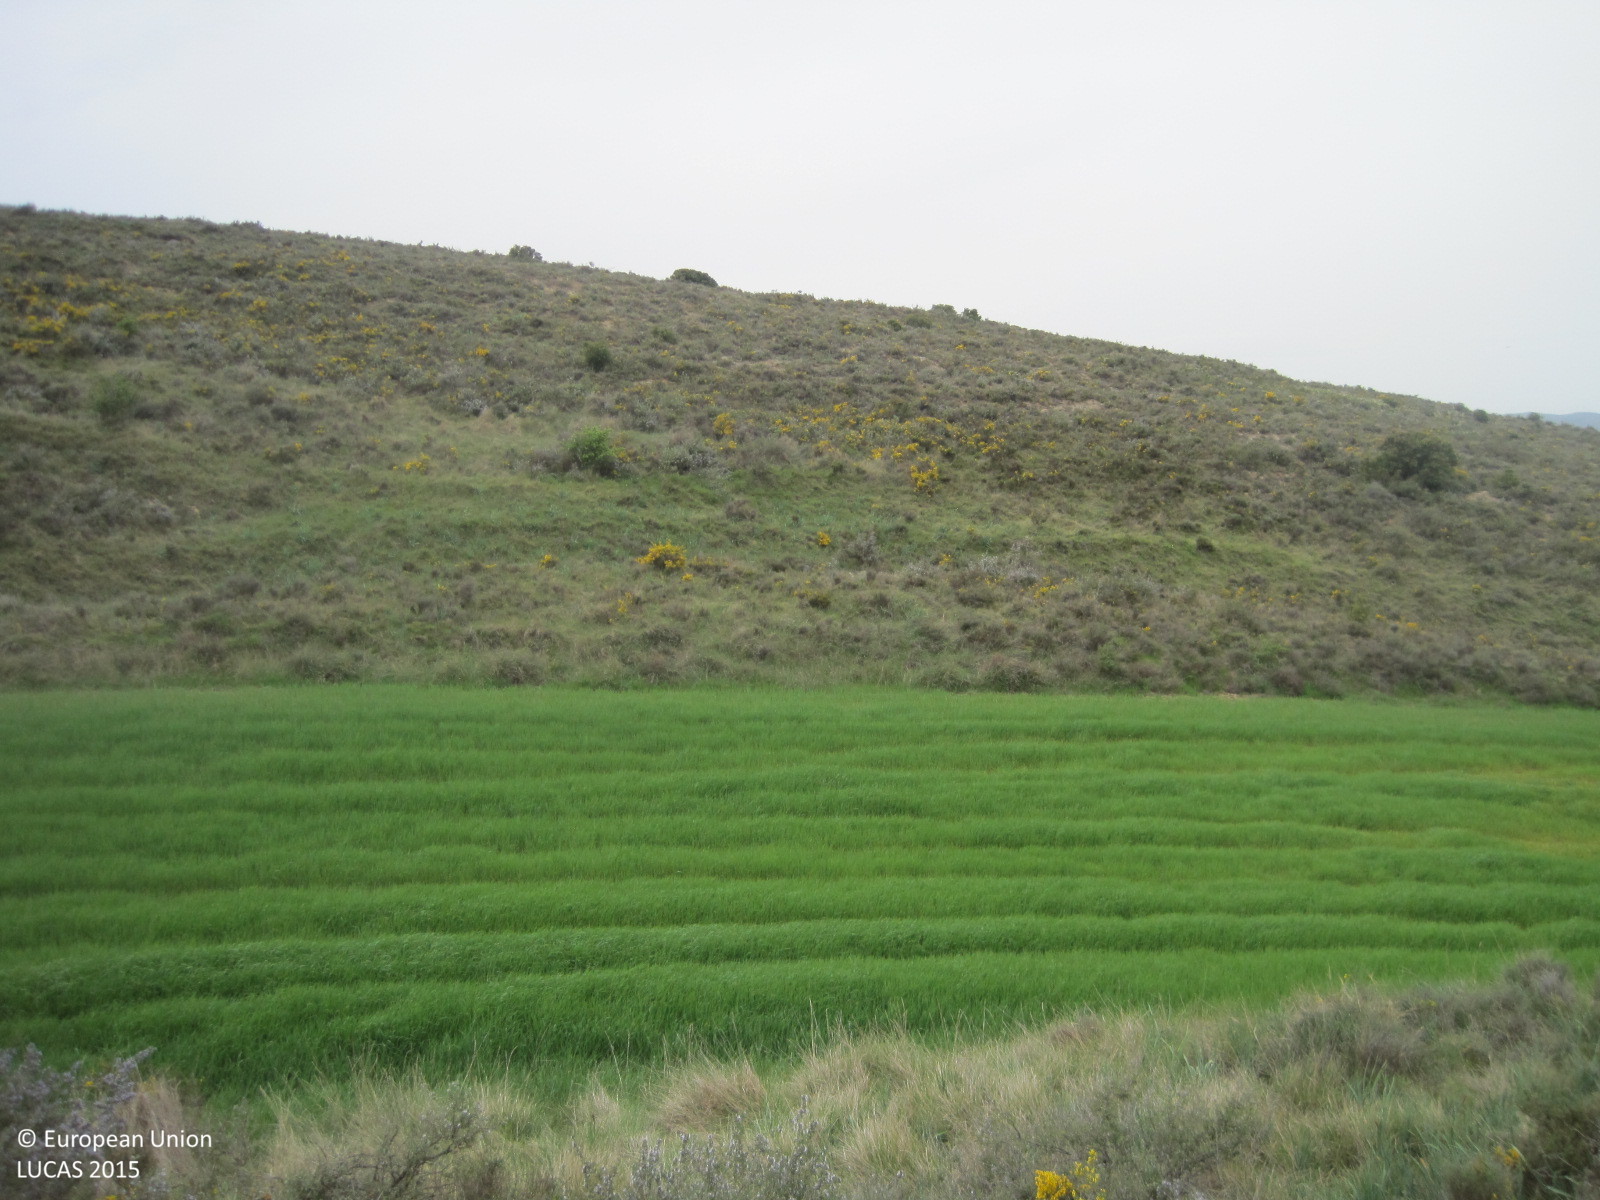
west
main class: Shrubland
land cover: Shrubland without tree cover
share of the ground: > 75 %
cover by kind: shrubs 60 %, unconsolidated bare surface 40 %
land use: Semi-natural and natural areas not in use
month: April
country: ES
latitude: 42.5183
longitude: -2.1777
